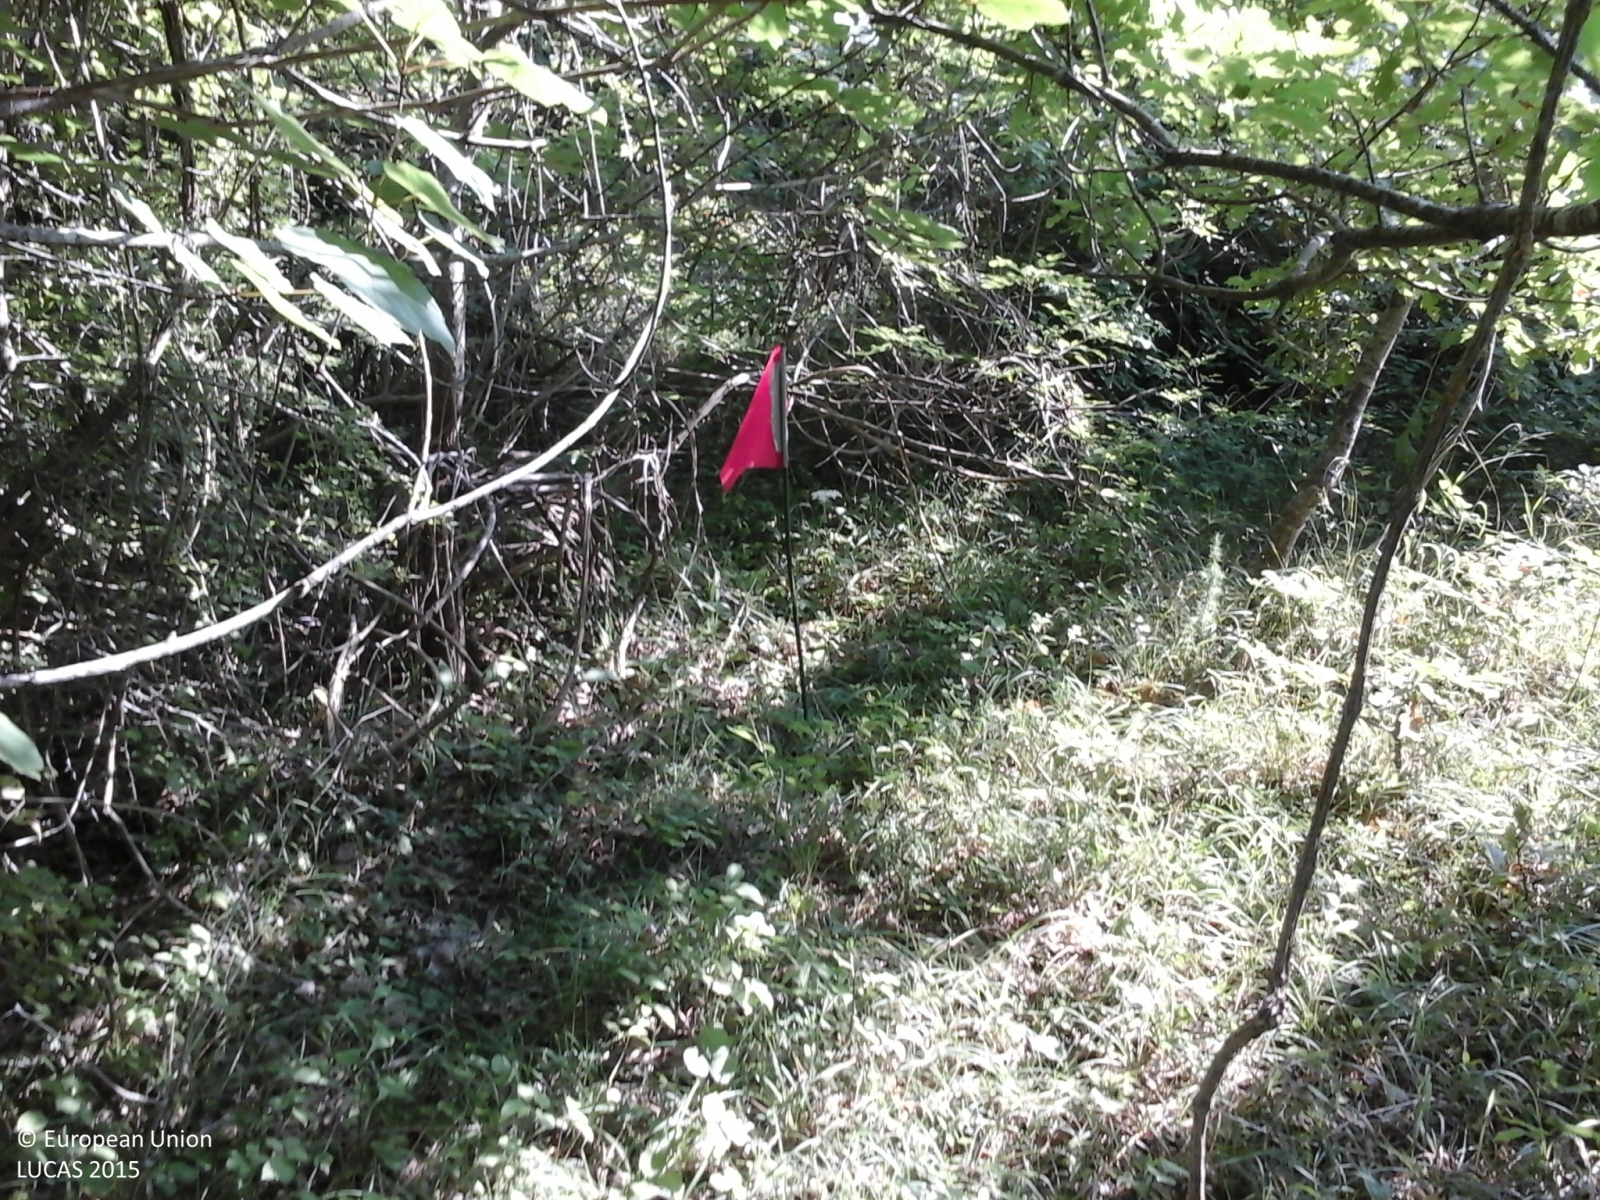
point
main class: Woodland
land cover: Broadleaved woodland
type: thermophilous deciduous forest
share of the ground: > 75 %
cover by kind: broadleaved forest trees 100 %
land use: Forestry
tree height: > 5 m
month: August
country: IT
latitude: 43.6204
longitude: 12.3361
